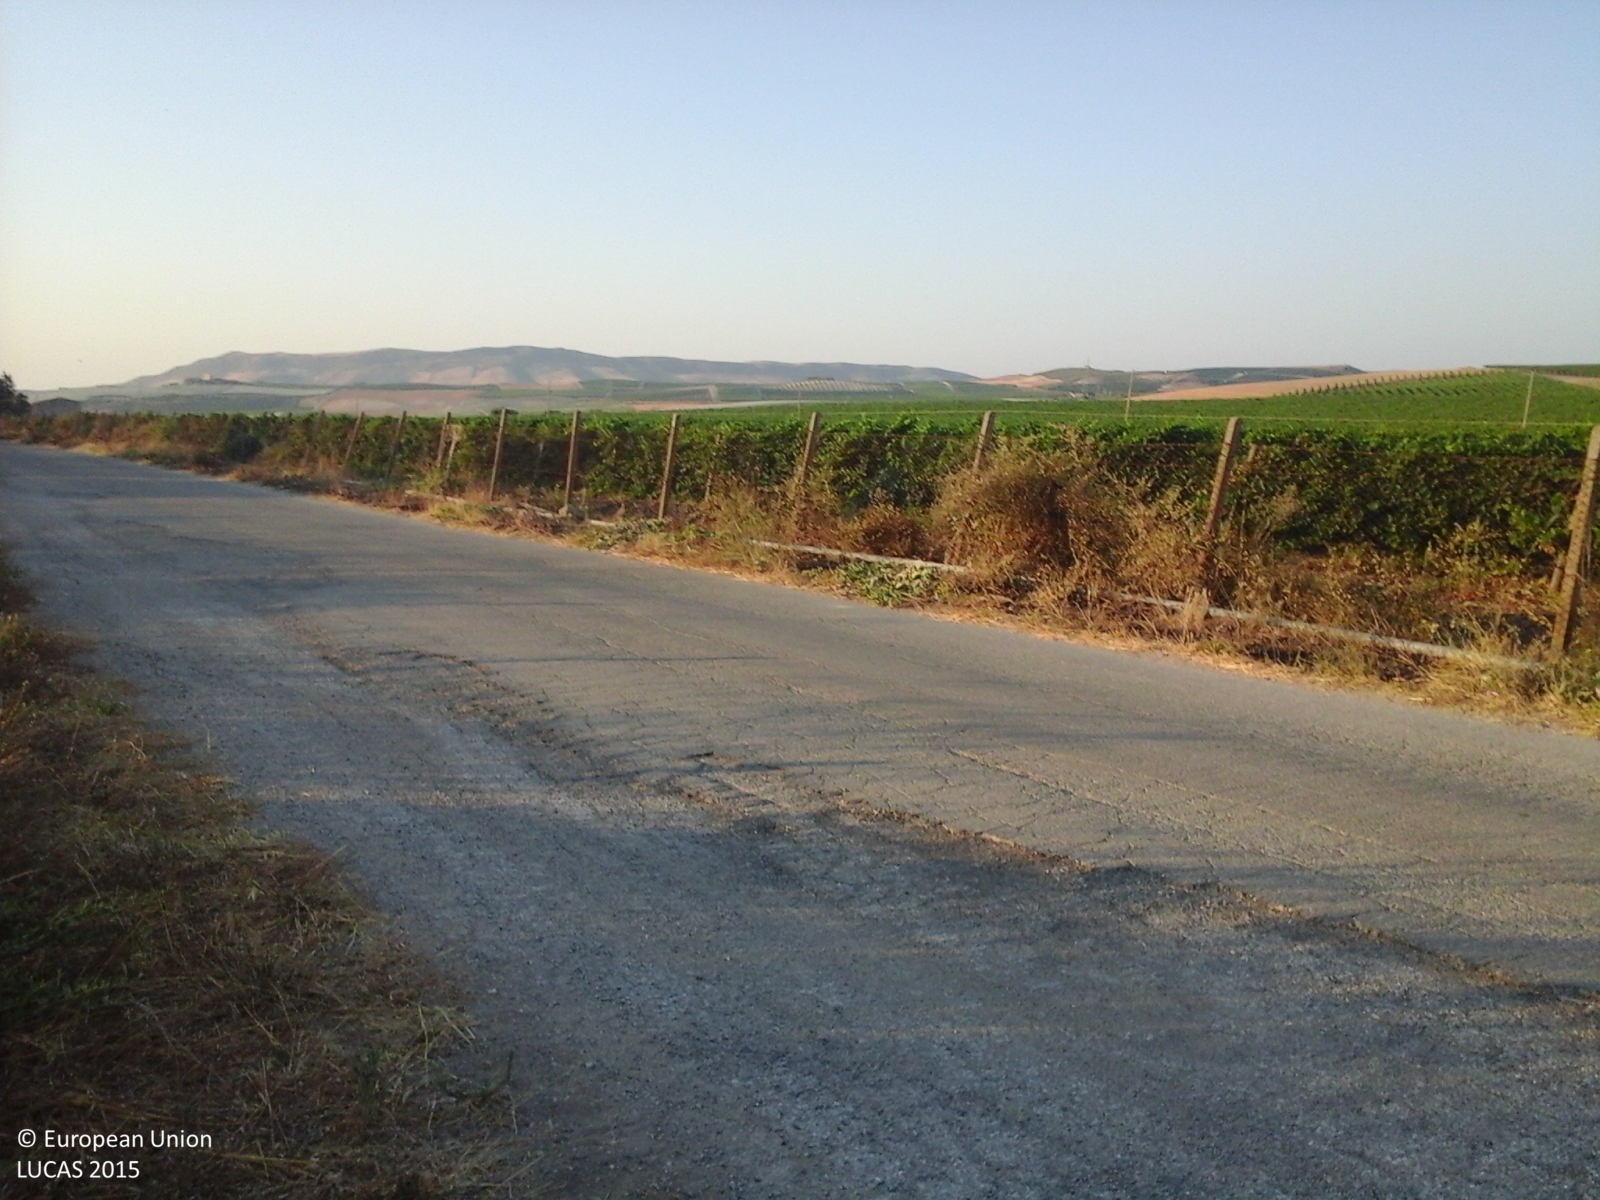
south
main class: Cropland
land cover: Durum wheat
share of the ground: > 75 %
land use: Agriculture (excluding fallow land and kitchen gardens)
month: July
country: IT
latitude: 37.1893
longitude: 14.0351
